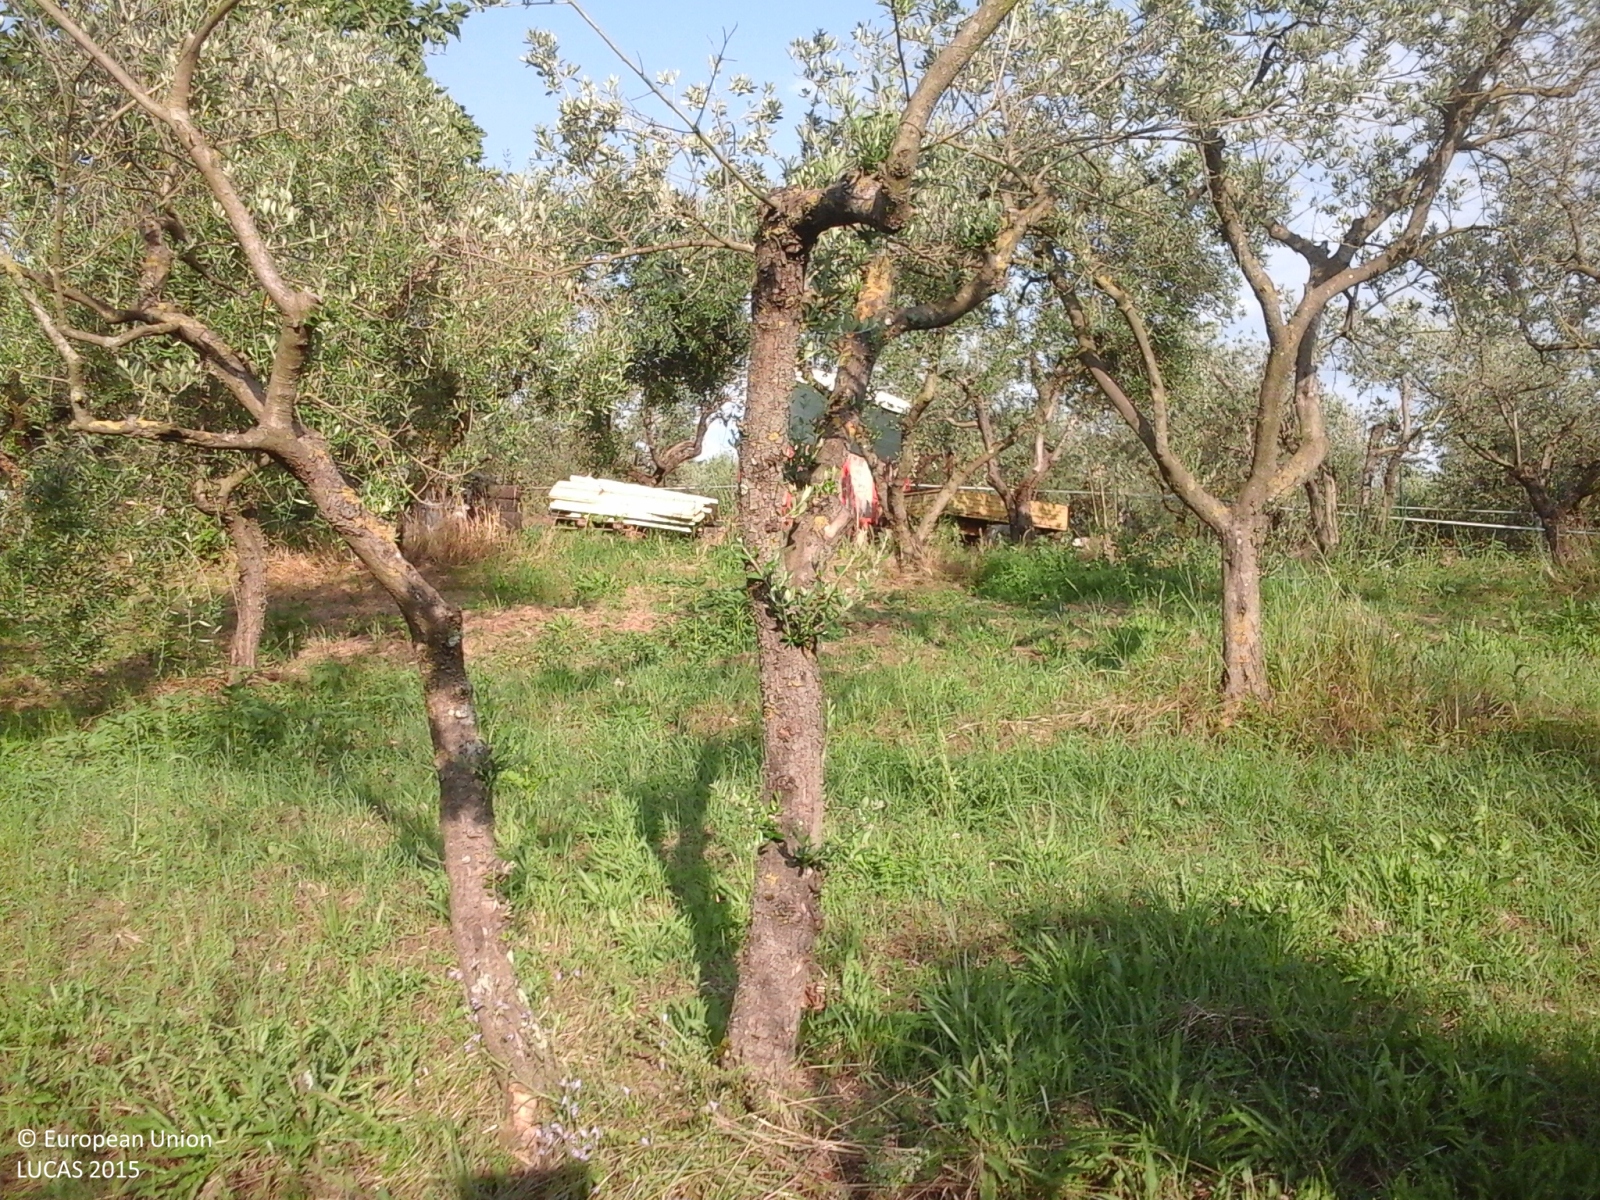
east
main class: Cropland
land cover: Olive groves
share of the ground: 25 - 50 %
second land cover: Grassland without tree/shrub cover
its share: > 75 %
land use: Agriculture (excluding fallow land and kitchen gardens)
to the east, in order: Olive groves; Grassland without tree/shrub cover; Artificial constructions in urban areas; Olive groves; Artificial constructions in urban areas; Olive groves; Artificial constructions in urban areas; Olive groves; Other fruit trees and berries; Abandoned hedges; Vineyards
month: June
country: IT
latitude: 41.8102
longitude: 13.1301
